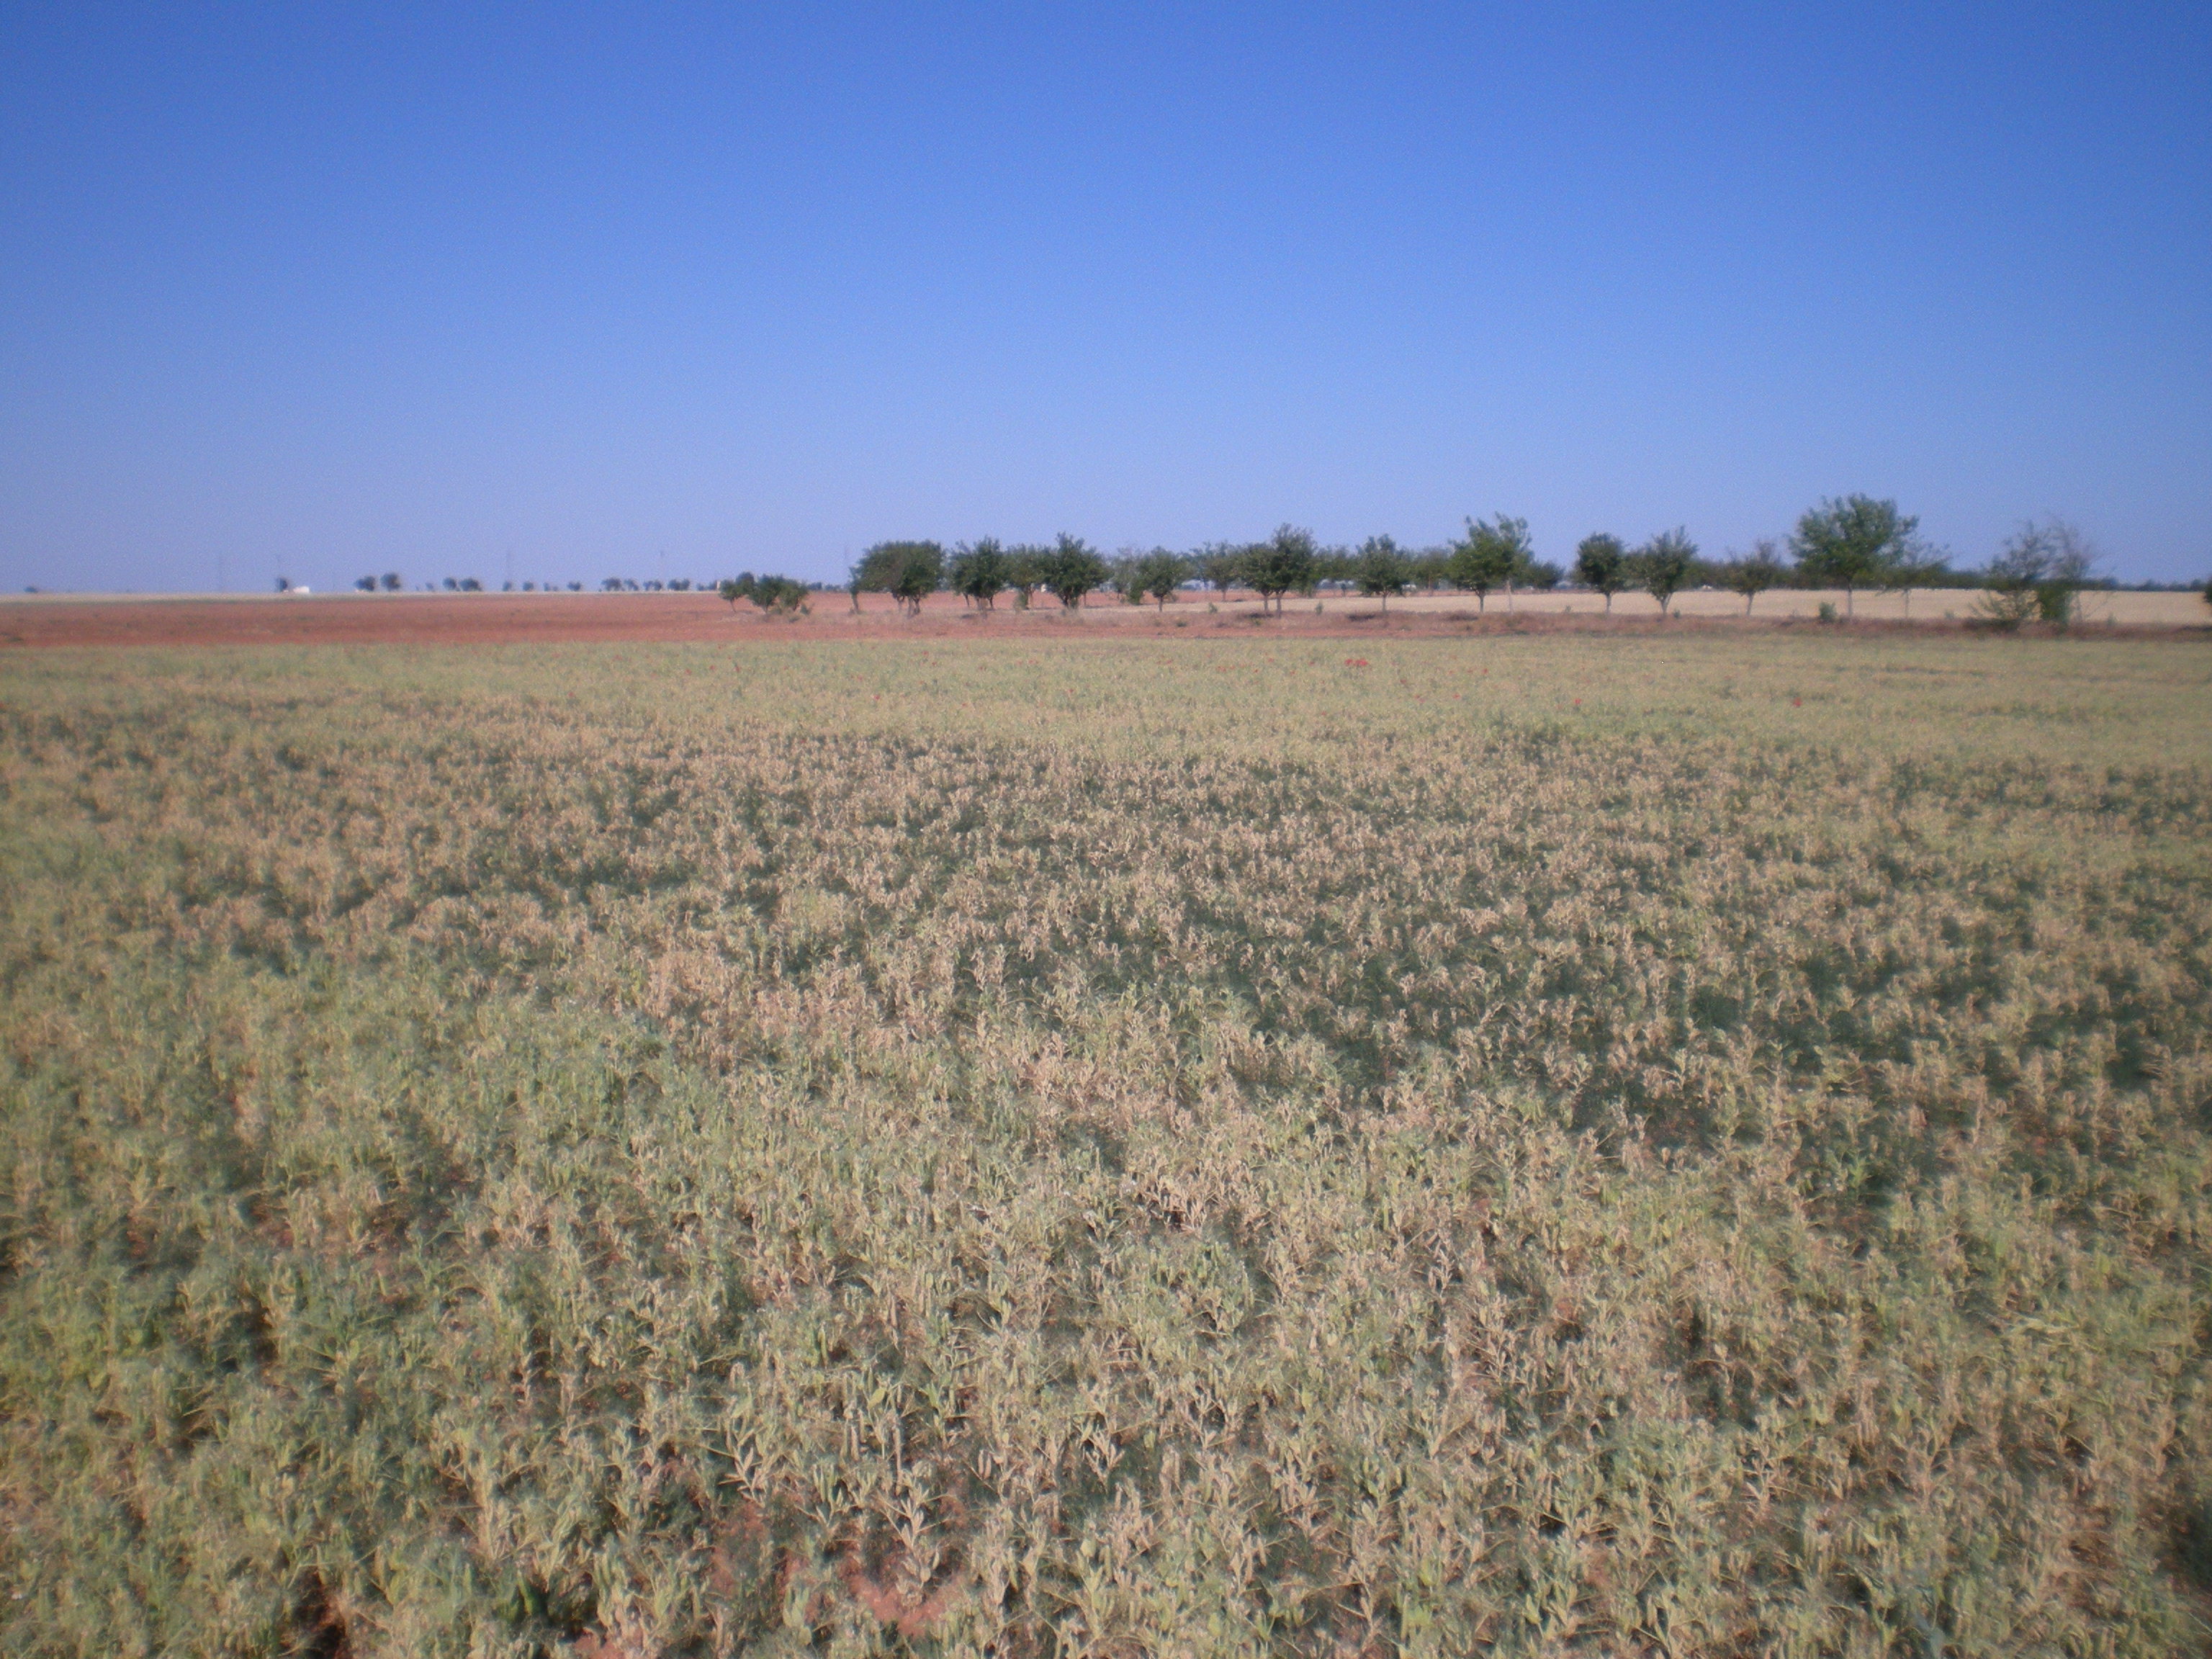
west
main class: Cropland
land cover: Dry pulses
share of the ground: 50 - 75 %
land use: Agriculture (excluding fallow land and kitchen gardens)
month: May
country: ES
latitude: 39.1009
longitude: -3.3009
